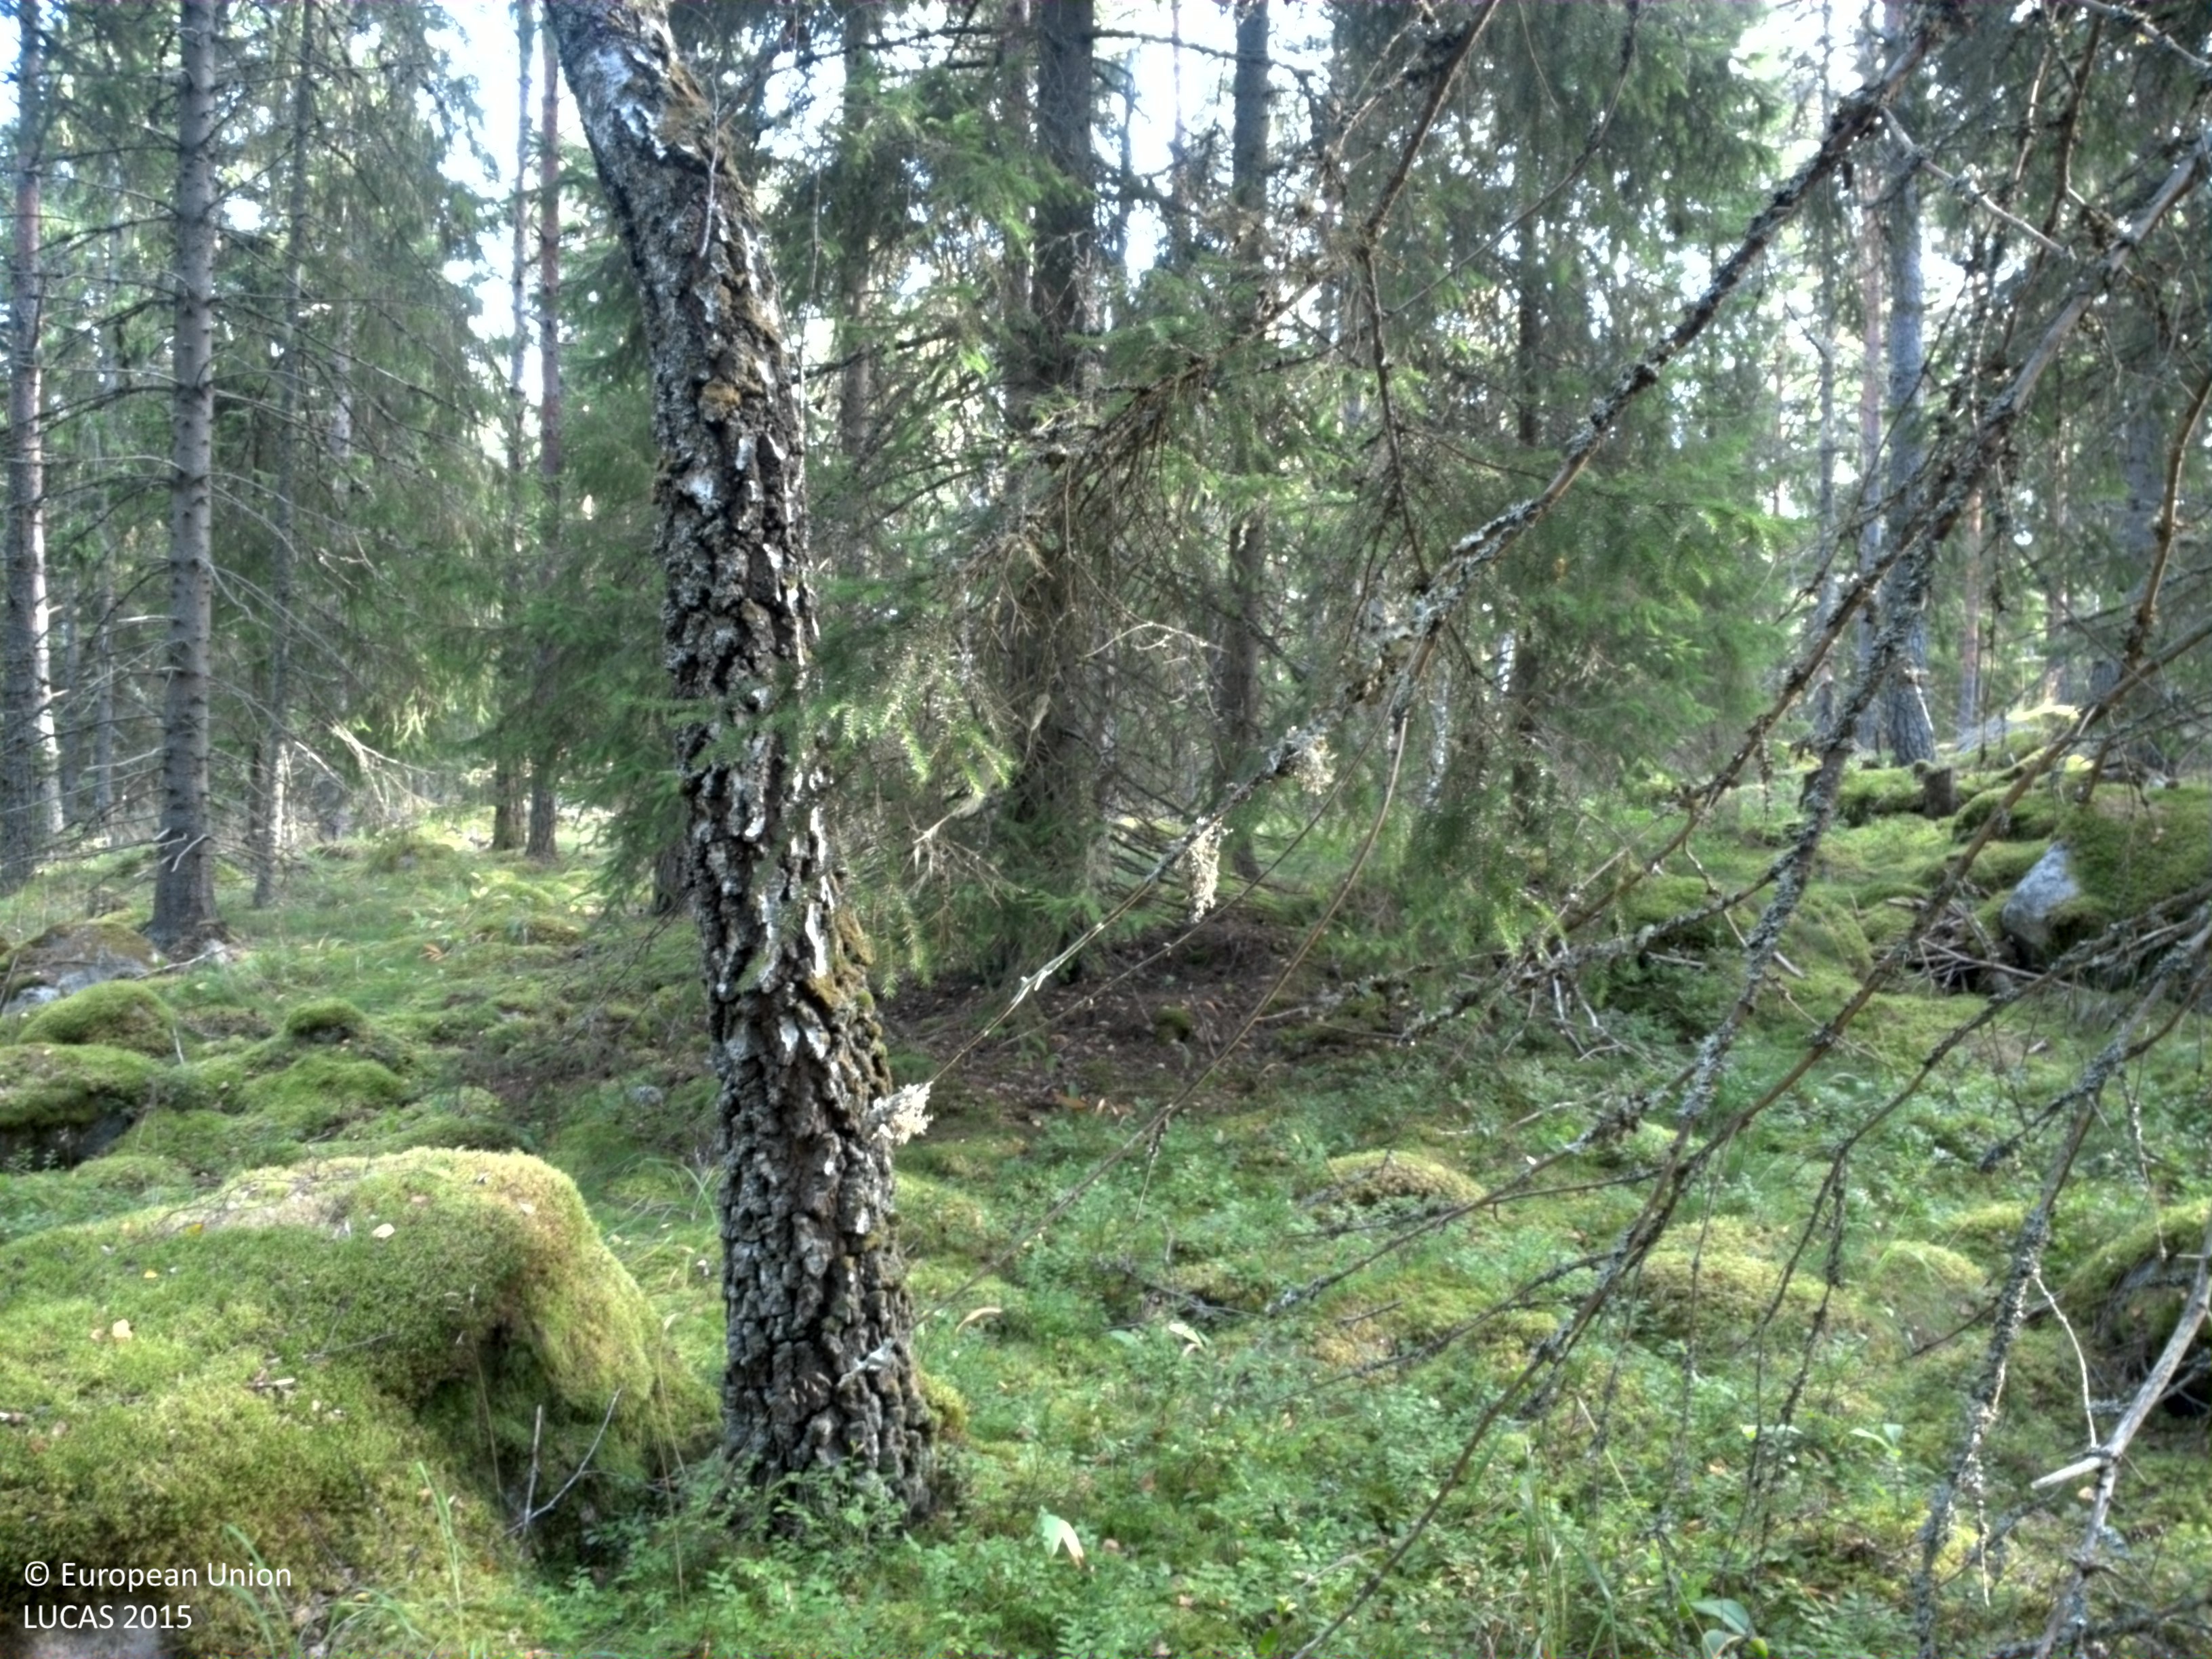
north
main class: Woodland
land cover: Spruce dominated coniferous woodland
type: boreal forest
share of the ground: > 75 %
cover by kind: coniferous forest trees 70 %, lichens and mosses 25 %, broadleaved forest trees 5 %
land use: Forestry
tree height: > 5 m
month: August
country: SE
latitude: 59.8145
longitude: 17.8945
